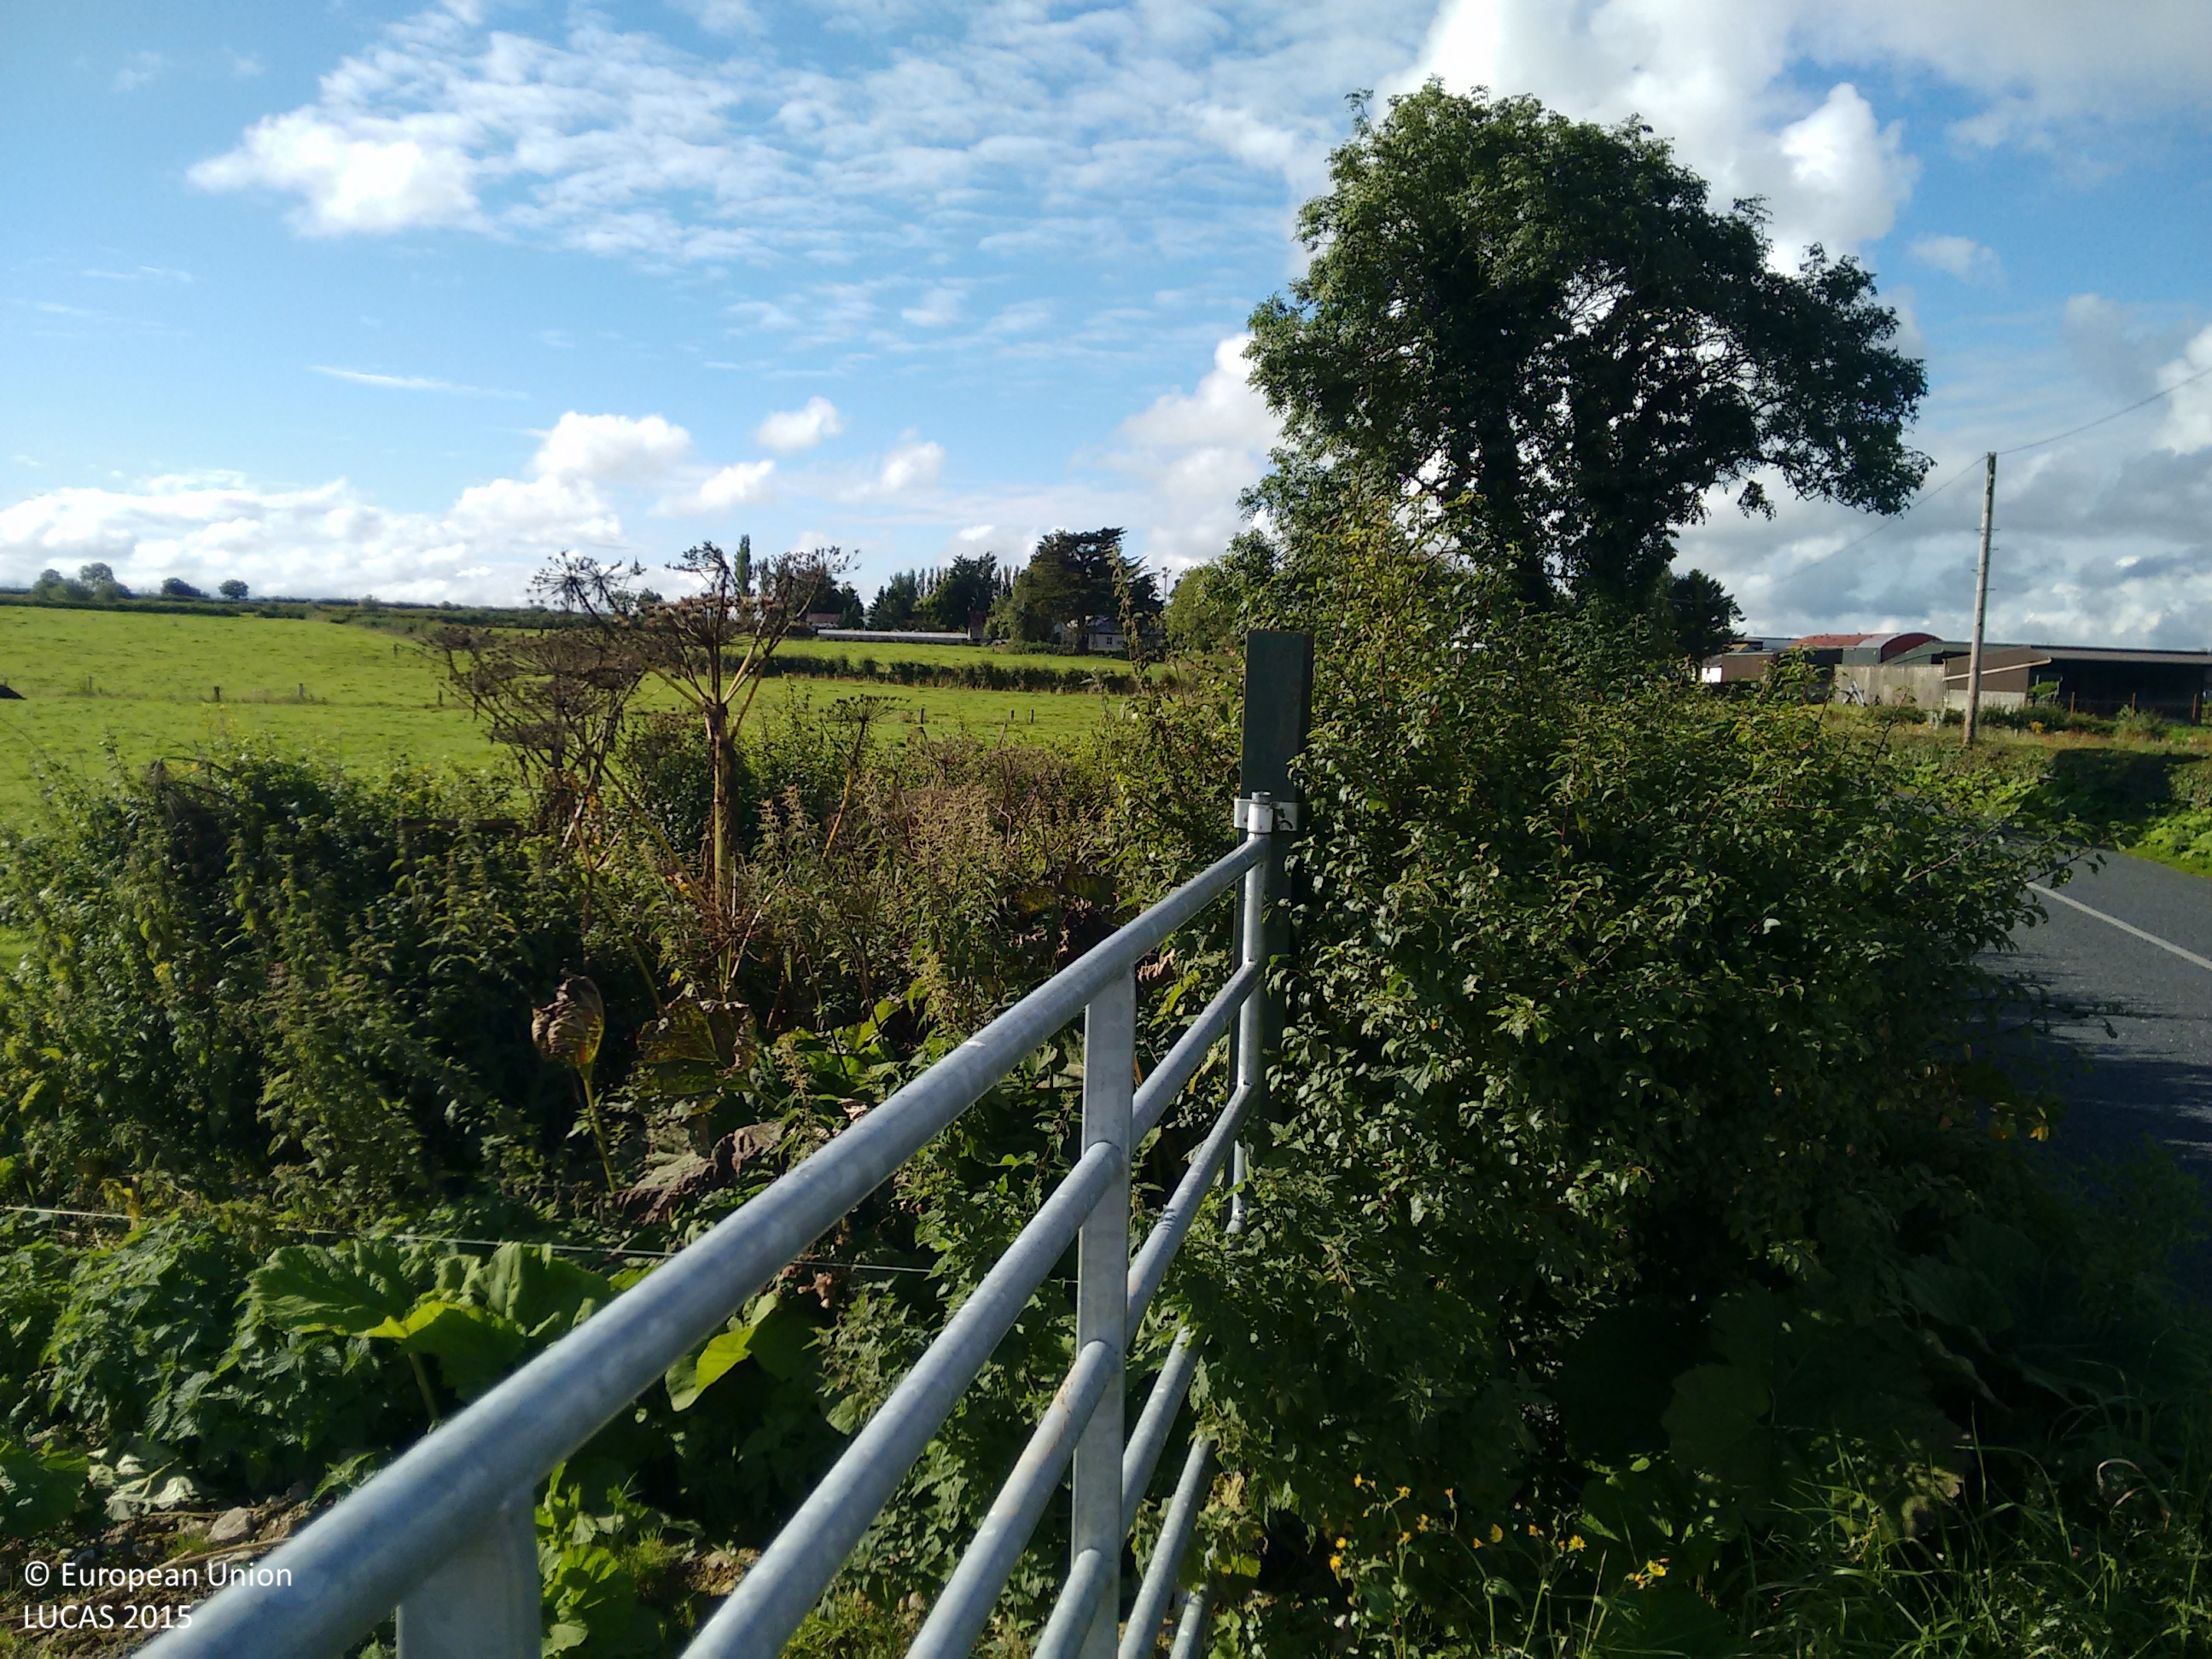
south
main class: Grassland
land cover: Grassland without tree/shrub cover
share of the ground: > 75 %
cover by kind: herbaceous plants 100 %
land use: Agriculture (excluding fallow land and kitchen gardens)
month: August
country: IE
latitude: 52.5682
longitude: -8.2584
